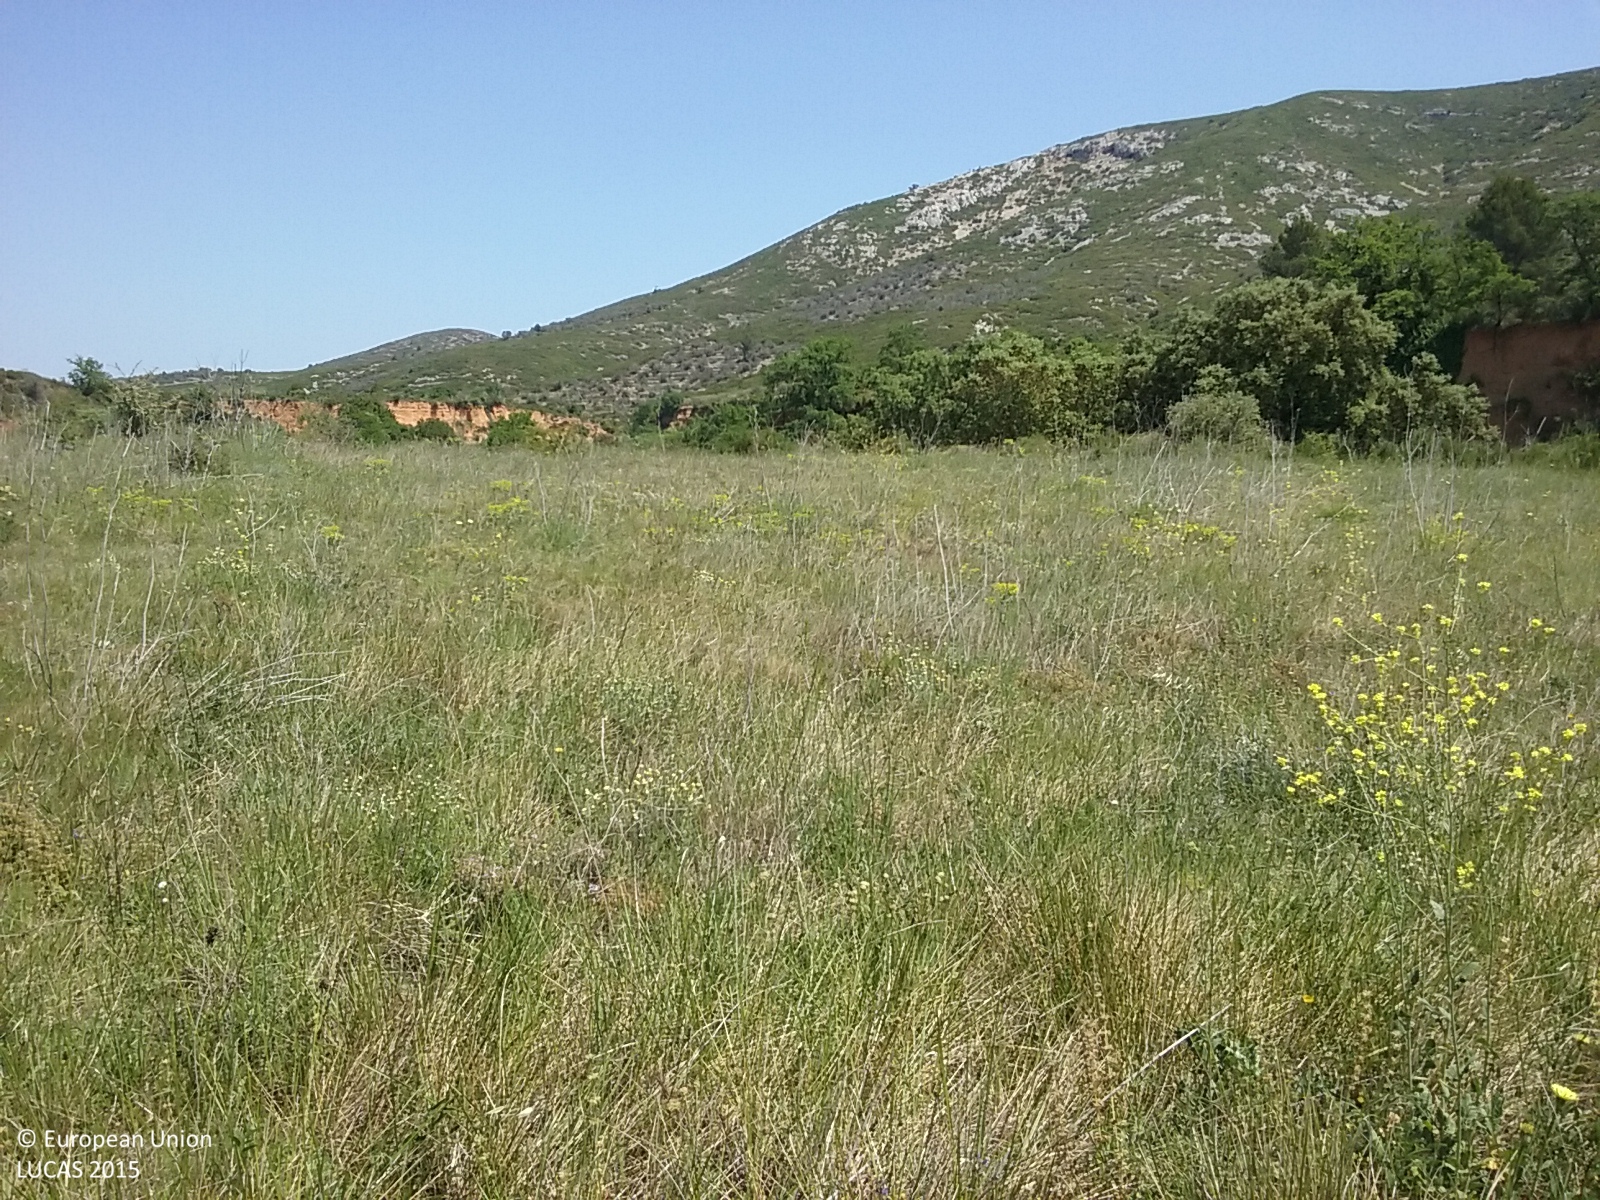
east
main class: Grassland
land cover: Grassland with sparse tree/shrub cover
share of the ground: > 75 %
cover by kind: herbaceous plants 90 %, broadleaved forest trees 5 %, shrubs 5 %
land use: Abandoned areas
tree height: > 5 m
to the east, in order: Grassland with sparse tree/shrub cover; Abandoned hedges; Dry stone walls; Grassland without tree/shrub cover; Dry stone walls; Shrubland with sparse tree cover; Dry stone walls; Shrubland with sparse tree cover; Tomatoes; Shrubland with sparse tree cover; Tracks; Shrubland with sparse tree cover; Rivers and streams; Shrubland with sparse tree cover; Tracks; Shrubland with sparse tree cover; Dry stone walls; Shrubland with sparse tree cover; Dry stone walls; Shrubland with sparse tree cover
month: May
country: ES
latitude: 40.5457
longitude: 0.2536
